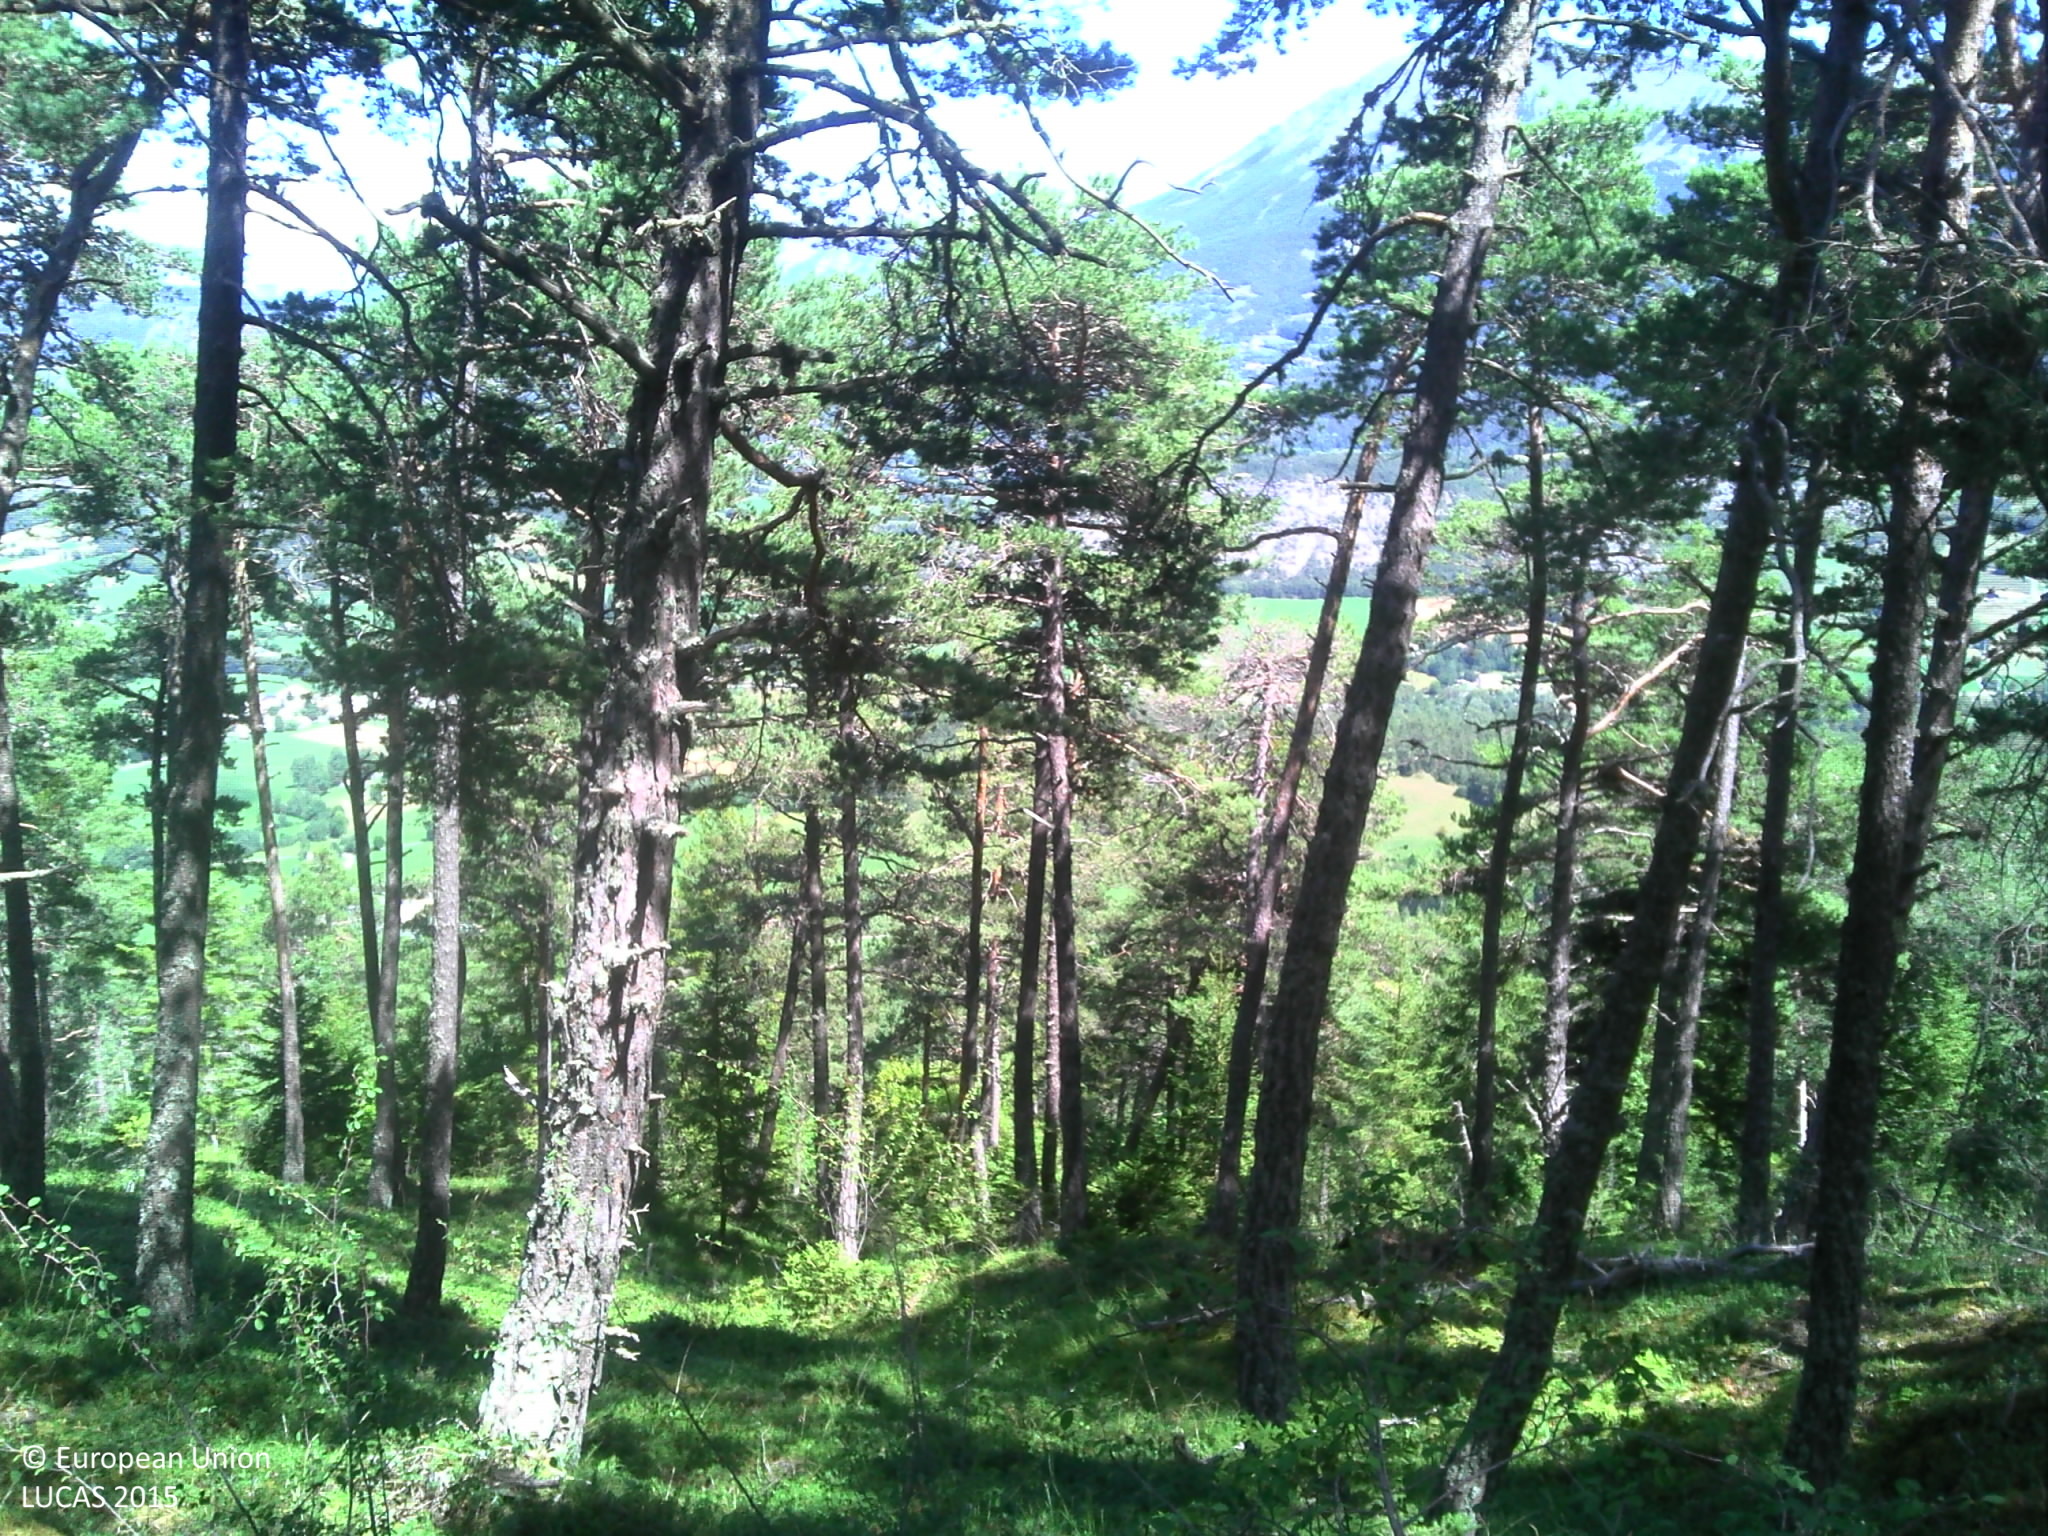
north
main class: Woodland
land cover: Pine dominated coniferous woodland
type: alpine coniferous forest
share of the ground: 50 - 75 %
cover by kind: coniferous forest trees 65 %, lichens and mosses 15 %, shrubs 10 %, herbaceous plants 10 %
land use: Forestry
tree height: > 5 m
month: August
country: FR
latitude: 44.3570
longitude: 6.3057
